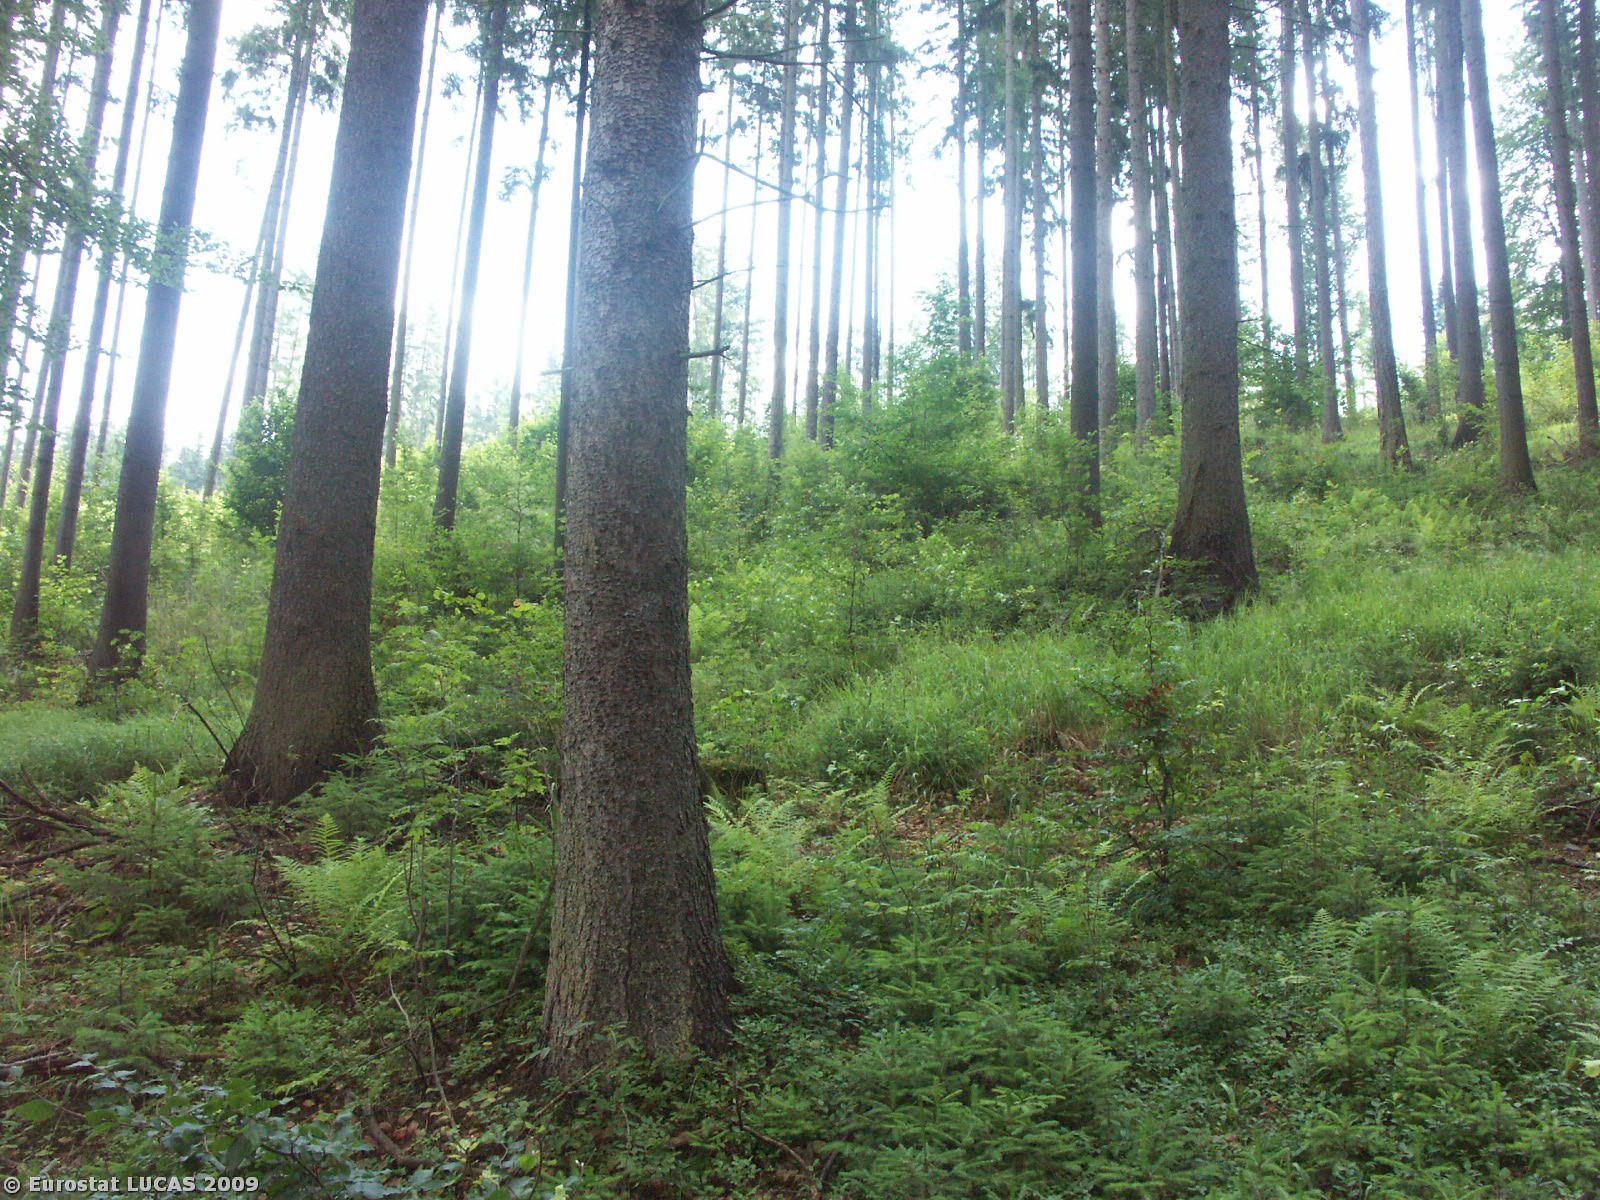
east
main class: Woodland
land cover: Coniferous woodland
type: hemiboreal forest and nemoral coniferous forest and mixed broadleaved-coniferous forest
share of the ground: > 75 %
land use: Forestry
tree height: > 5 m
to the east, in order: Coniferous woodland; Mixed woodland; Tracks; Mixed woodland; Tracks; Coniferous woodland; Grassland without tree/shrub cover
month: July
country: CZ
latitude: 49.9429
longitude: 17.4111
